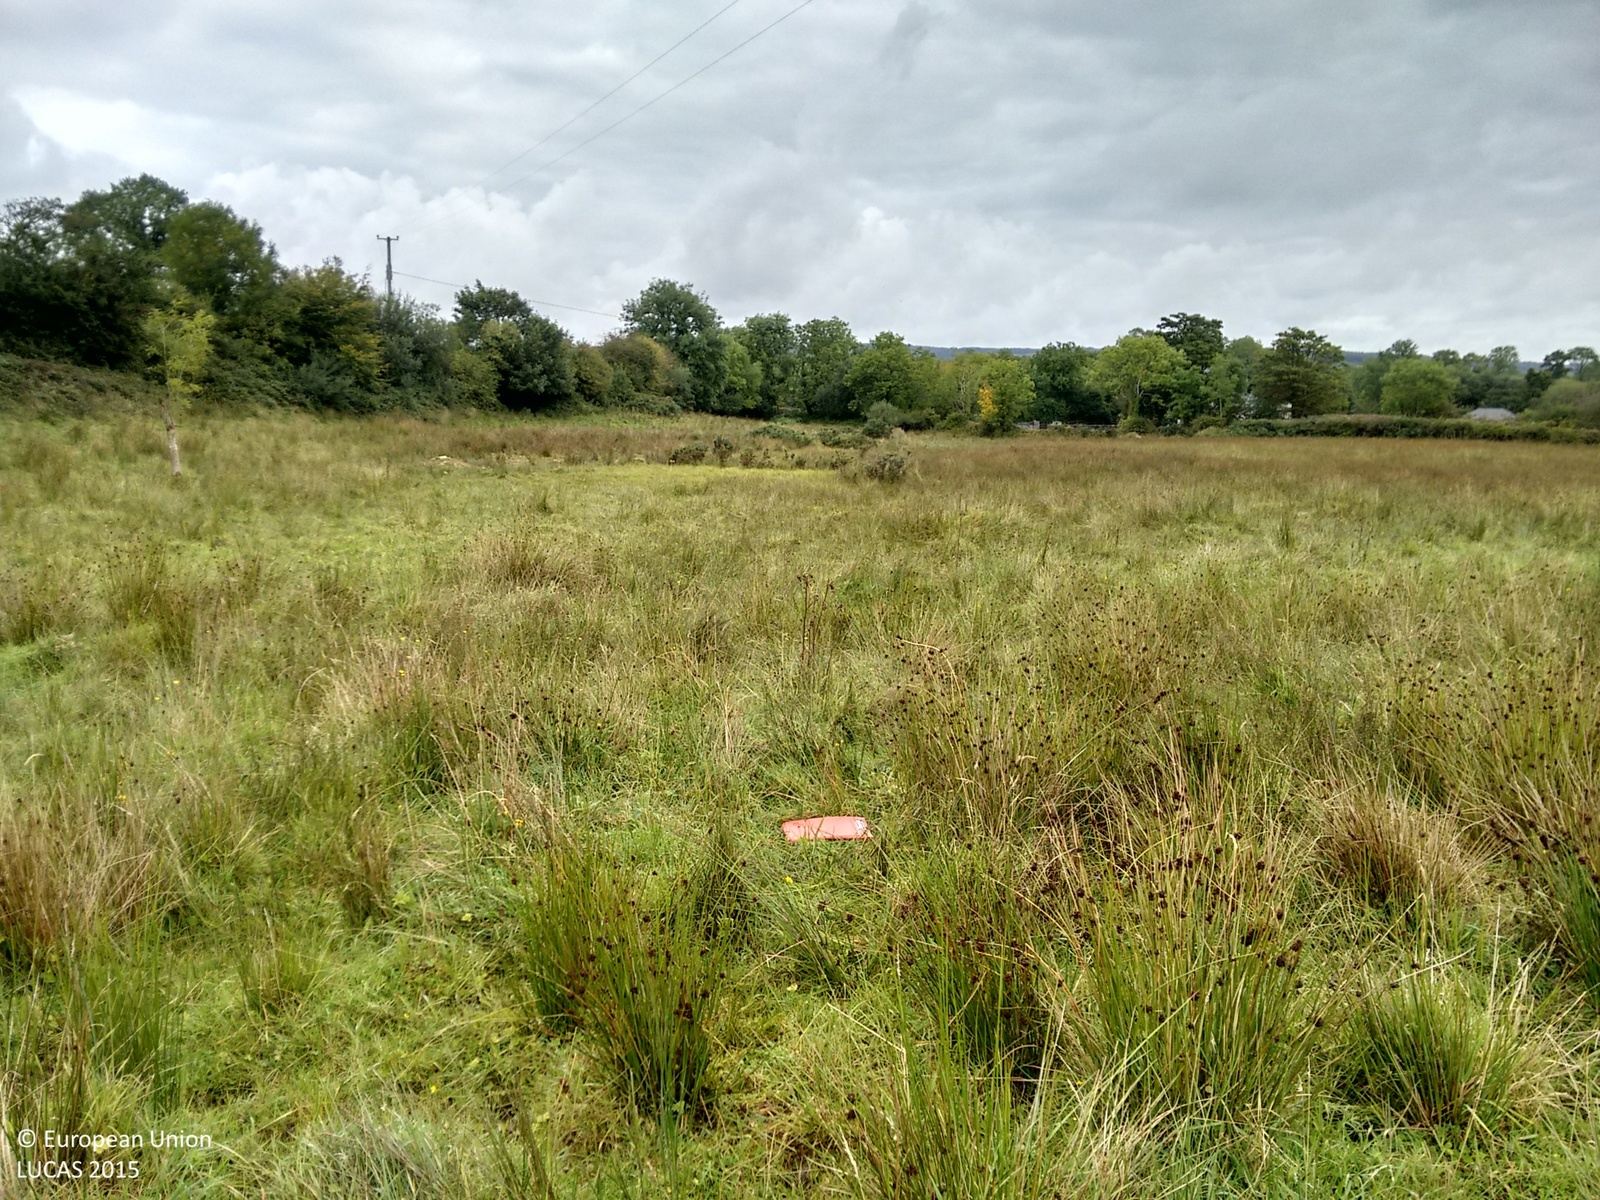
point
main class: Grassland
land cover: Grassland without tree/shrub cover
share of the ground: > 75 %
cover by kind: herbaceous plants 95 %
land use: Agriculture (excluding fallow land and kitchen gardens)
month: September
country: IE
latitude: 52.8943
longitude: -8.7695
